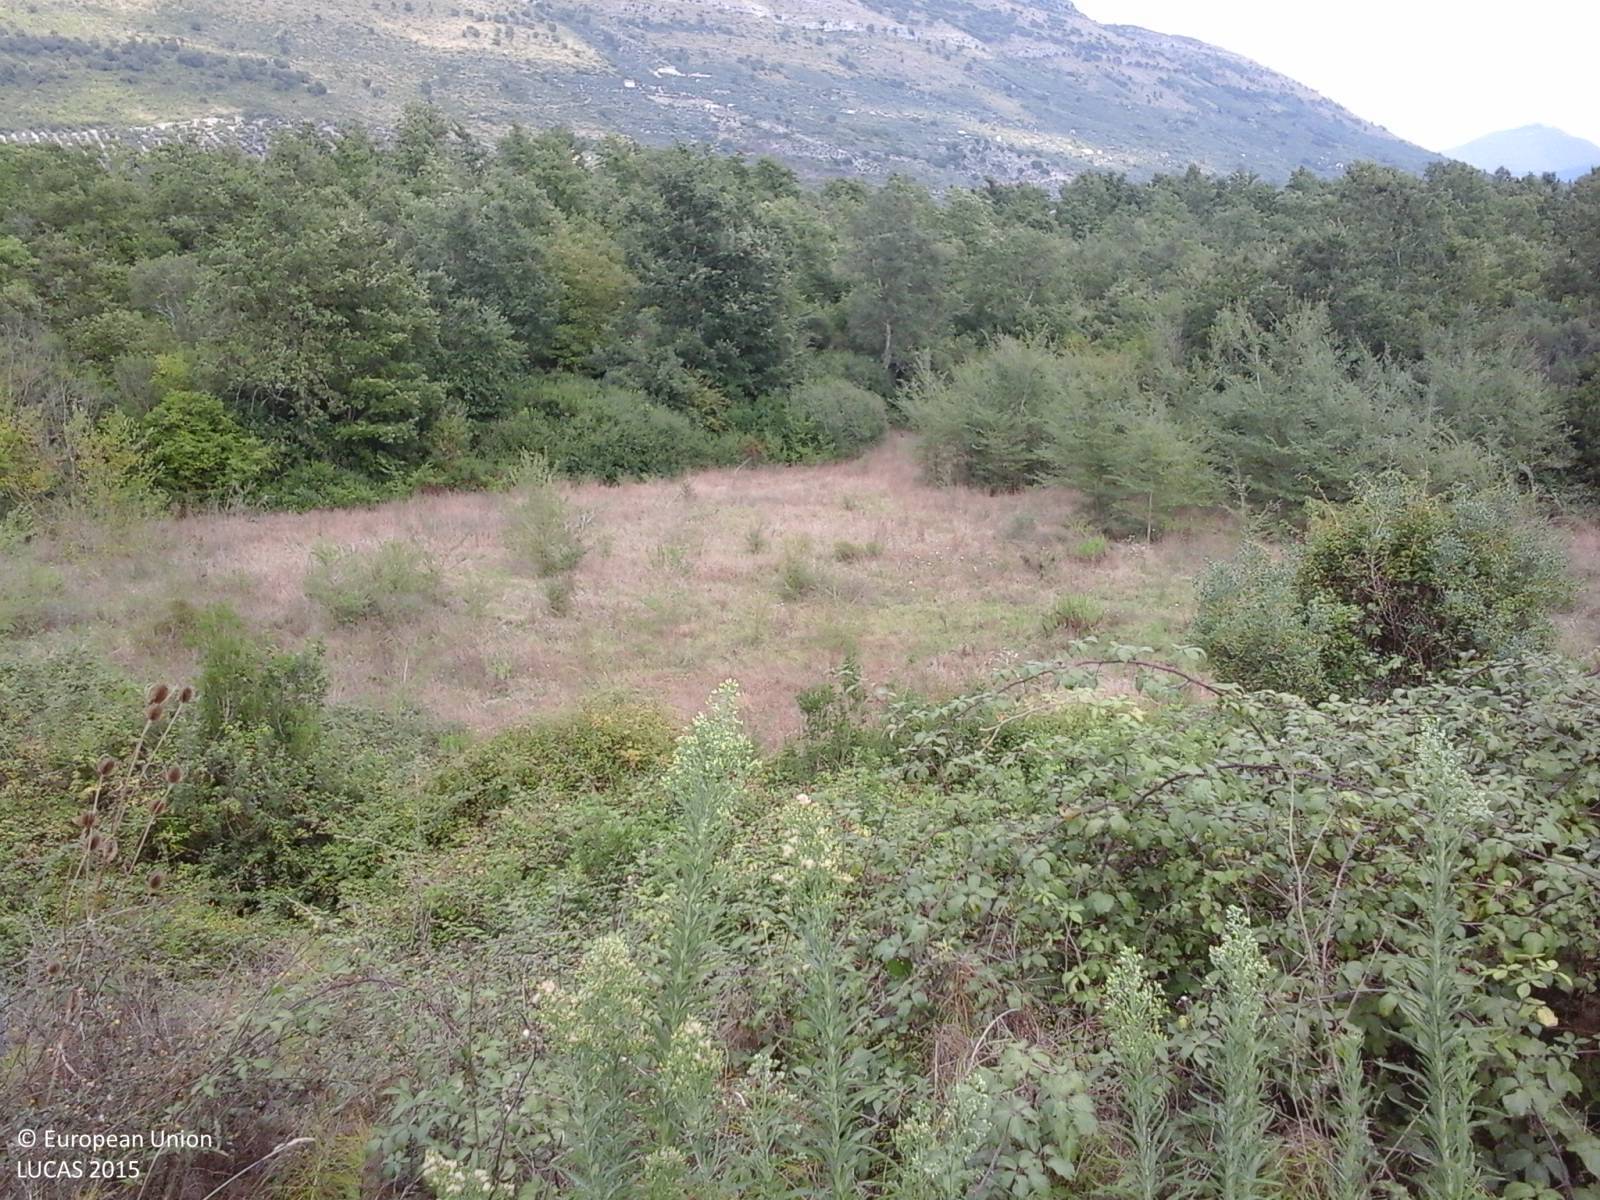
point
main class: Grassland
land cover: Grassland with sparse tree/shrub cover
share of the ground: > 75 %
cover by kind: herbaceous plants 85 %, shrubs 10 %, broadleaved forest trees 5 %
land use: Abandoned areas
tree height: < 5 m
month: August
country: IT
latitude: 41.4460
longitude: 13.2071
